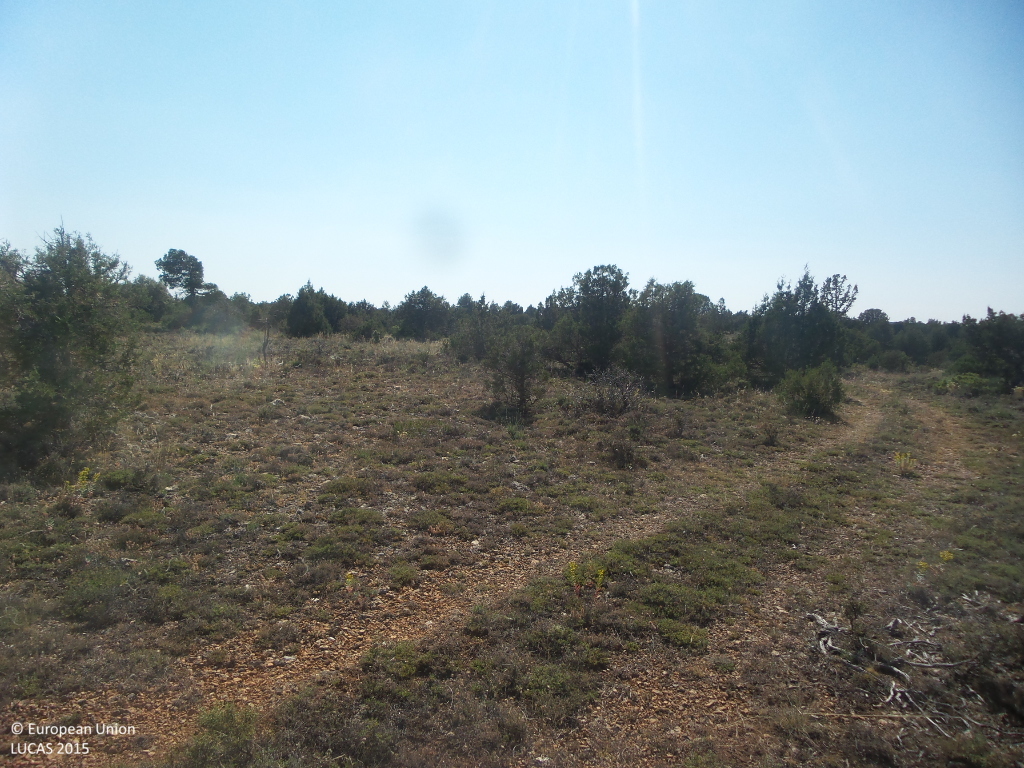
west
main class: Woodland
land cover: Other coniferous woodland
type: coniferous forest of the mediterranean region
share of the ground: 10 - 25 %
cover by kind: unconsolidated bare surface 45 %, shrubs 35 %, coniferous forest trees 15 %, herbaceous plants 5 %
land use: Semi-natural and natural areas not in use
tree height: < 5 m
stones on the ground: 25 - 50 %
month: July
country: ES
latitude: 41.1208
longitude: -2.1163
